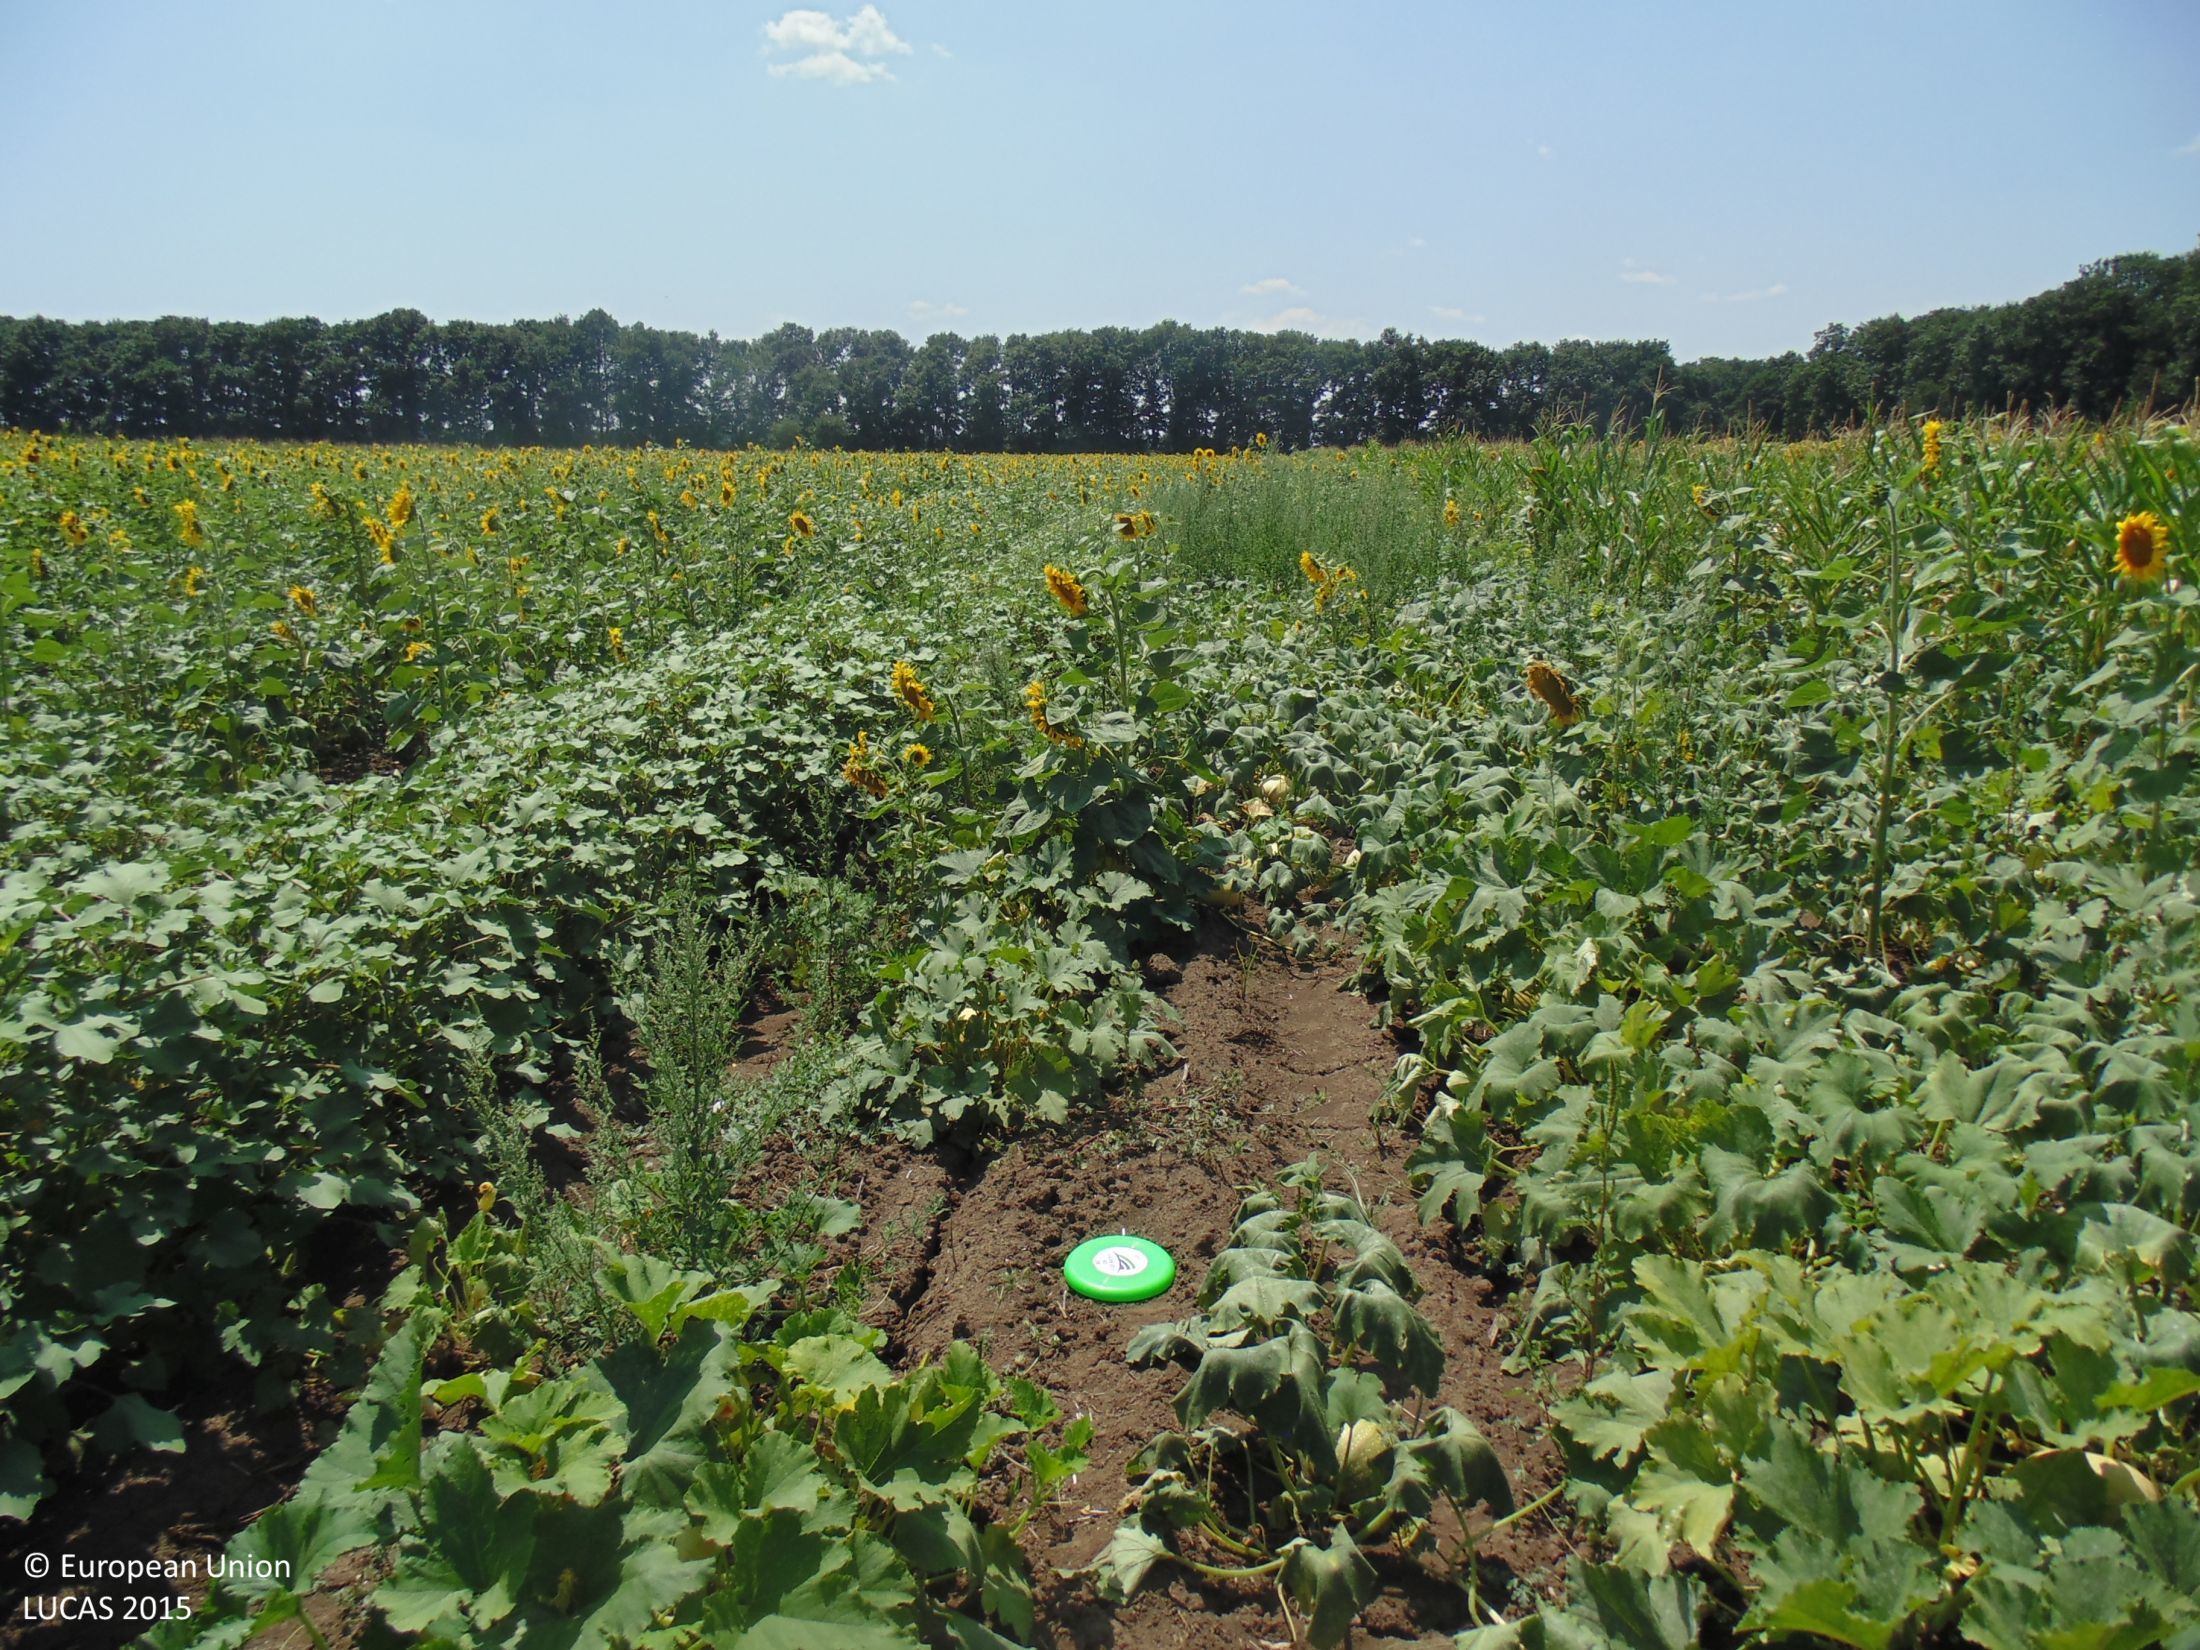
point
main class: Cropland
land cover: Other fresh vegetables
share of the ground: > 75 %
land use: Agriculture (excluding fallow land and kitchen gardens)
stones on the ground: < 10 %
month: July
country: BG
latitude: 43.6294
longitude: 27.6751
